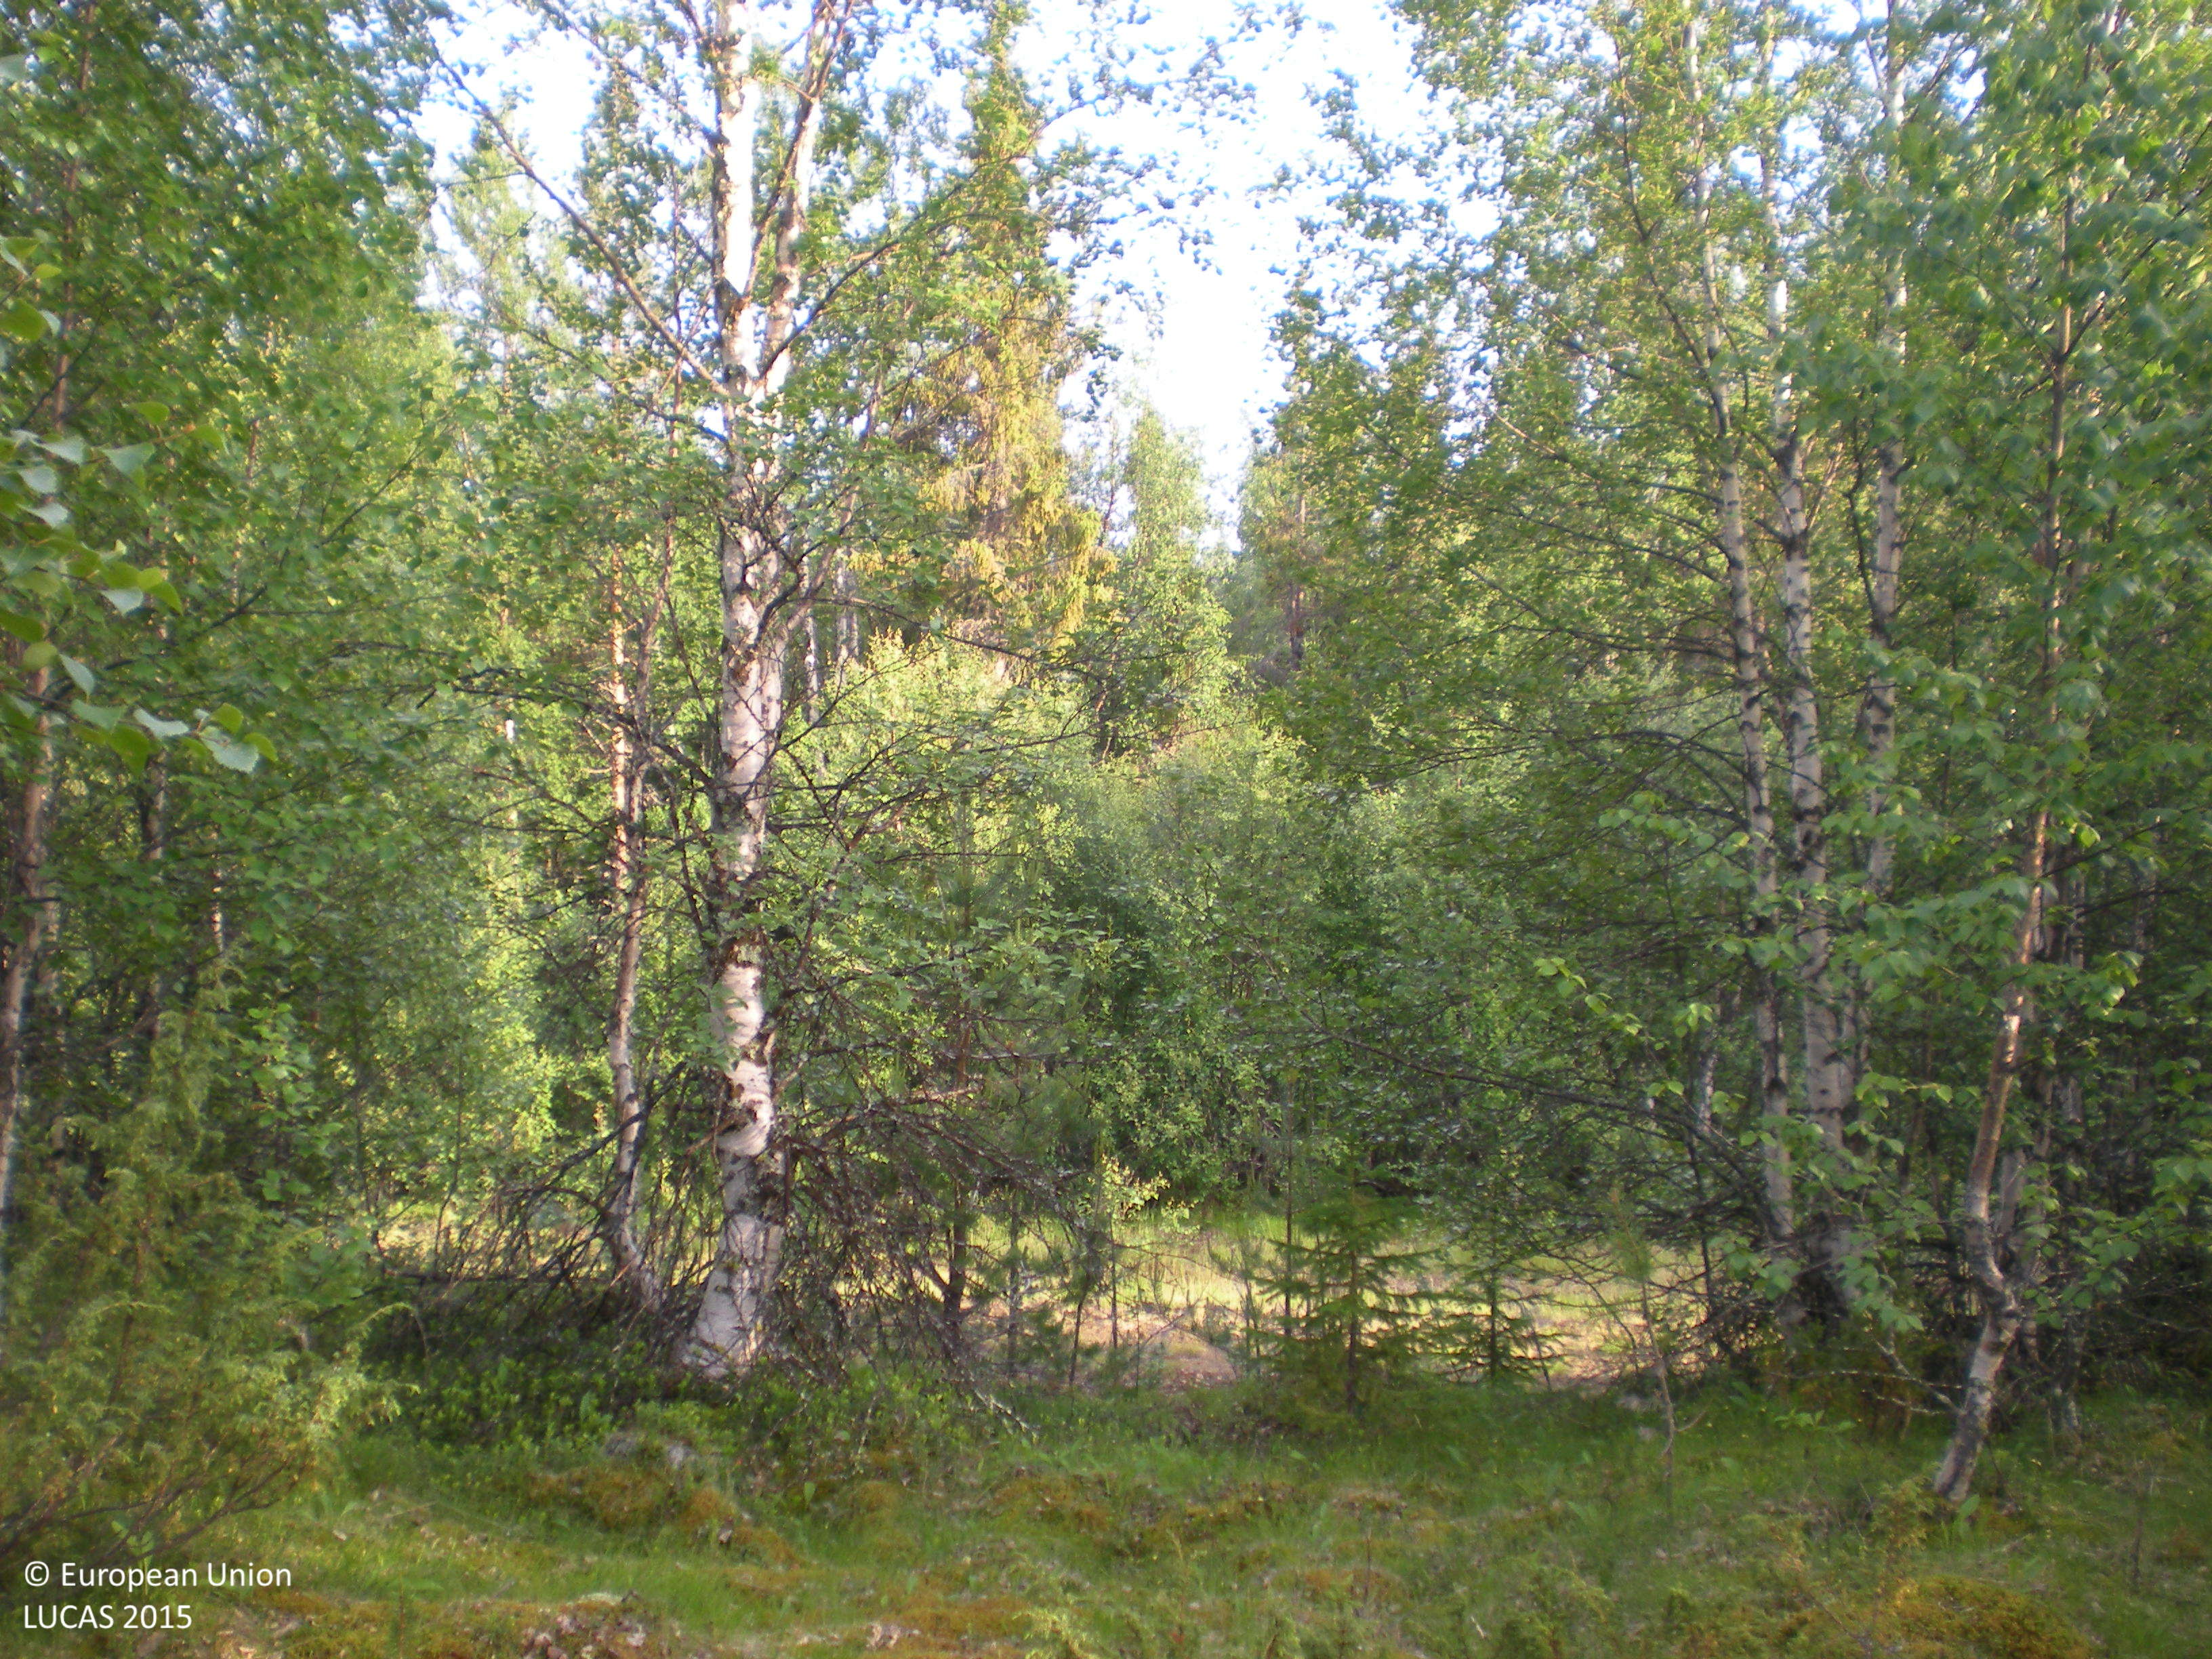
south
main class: Woodland
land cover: Broadleaved woodland
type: boreal forest
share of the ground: 50 - 75 %
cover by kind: broadleaved forest trees 70 %, lichens and mosses 15 %, herbaceous plants 10 %, shrubs 5 %
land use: Forestry
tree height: > 5 m
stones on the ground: > 50 %
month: July
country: SE
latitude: 65.6097
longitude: 17.7066
